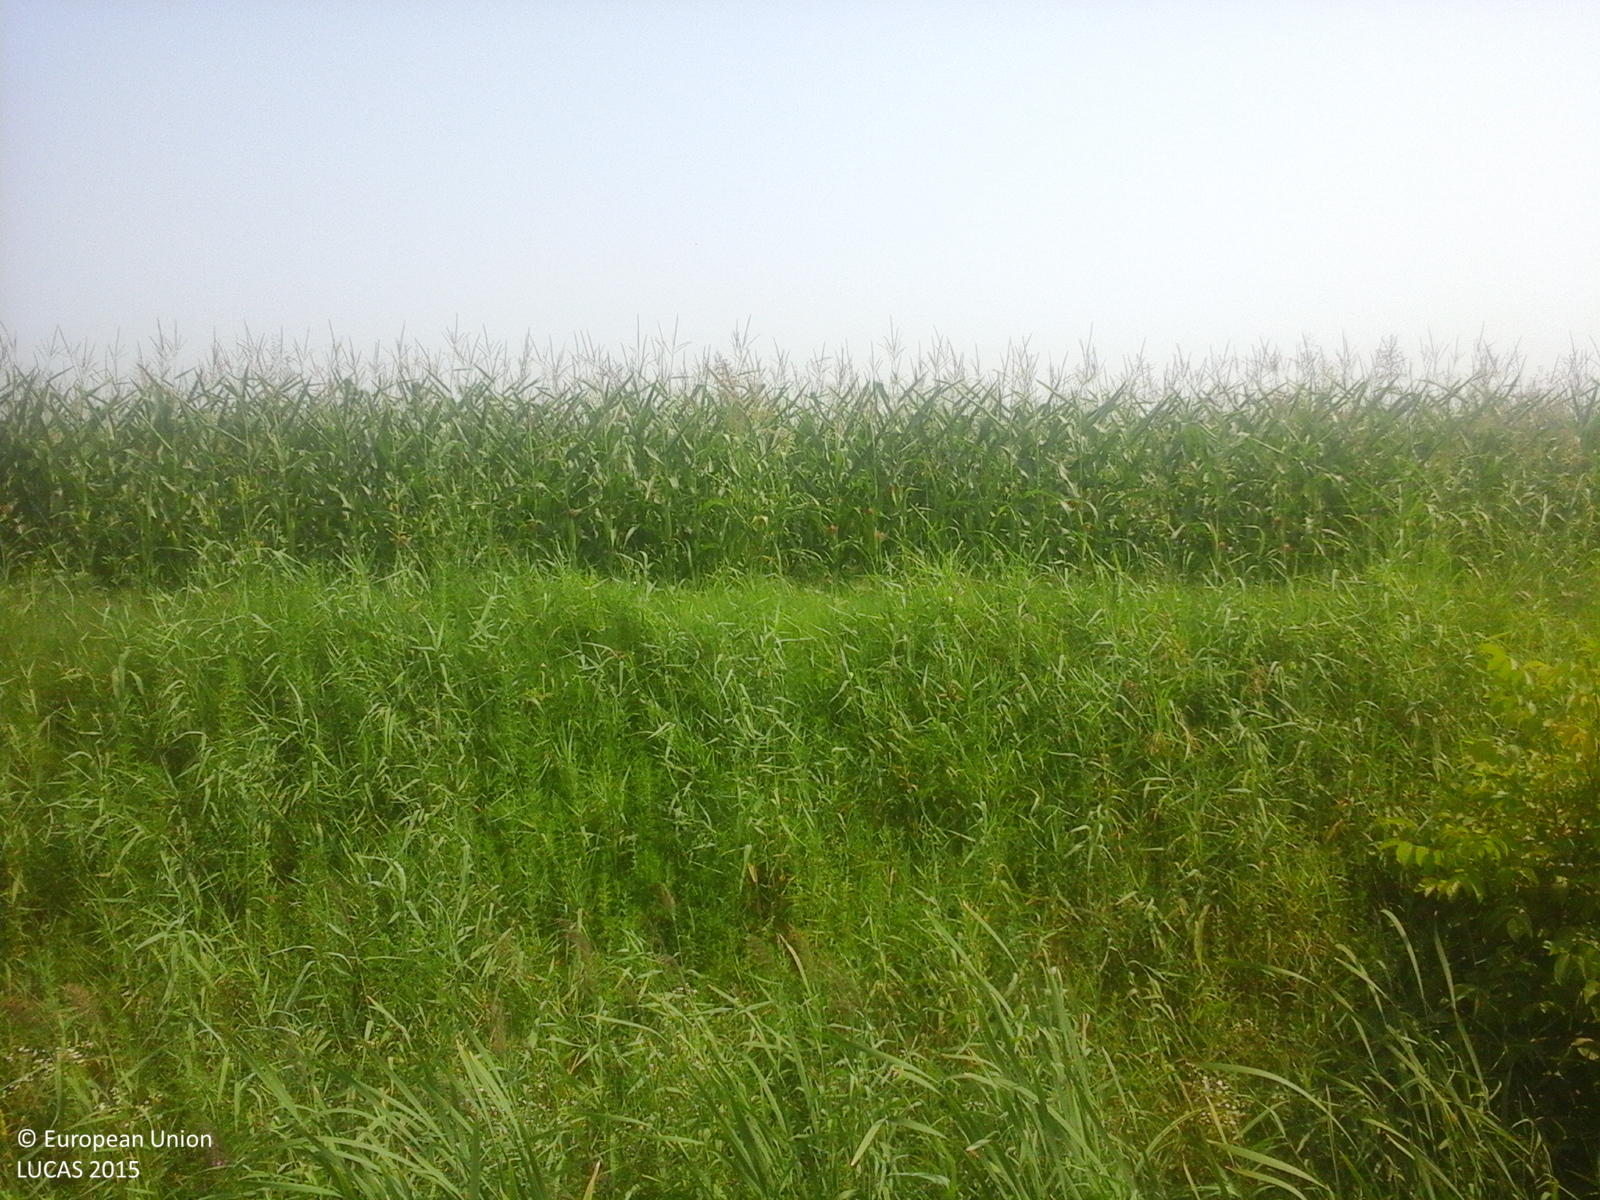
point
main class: Cropland
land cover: Maize
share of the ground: > 75 %
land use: Agriculture (excluding fallow land and kitchen gardens)
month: July
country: RO
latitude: 44.7562
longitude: 26.3212
